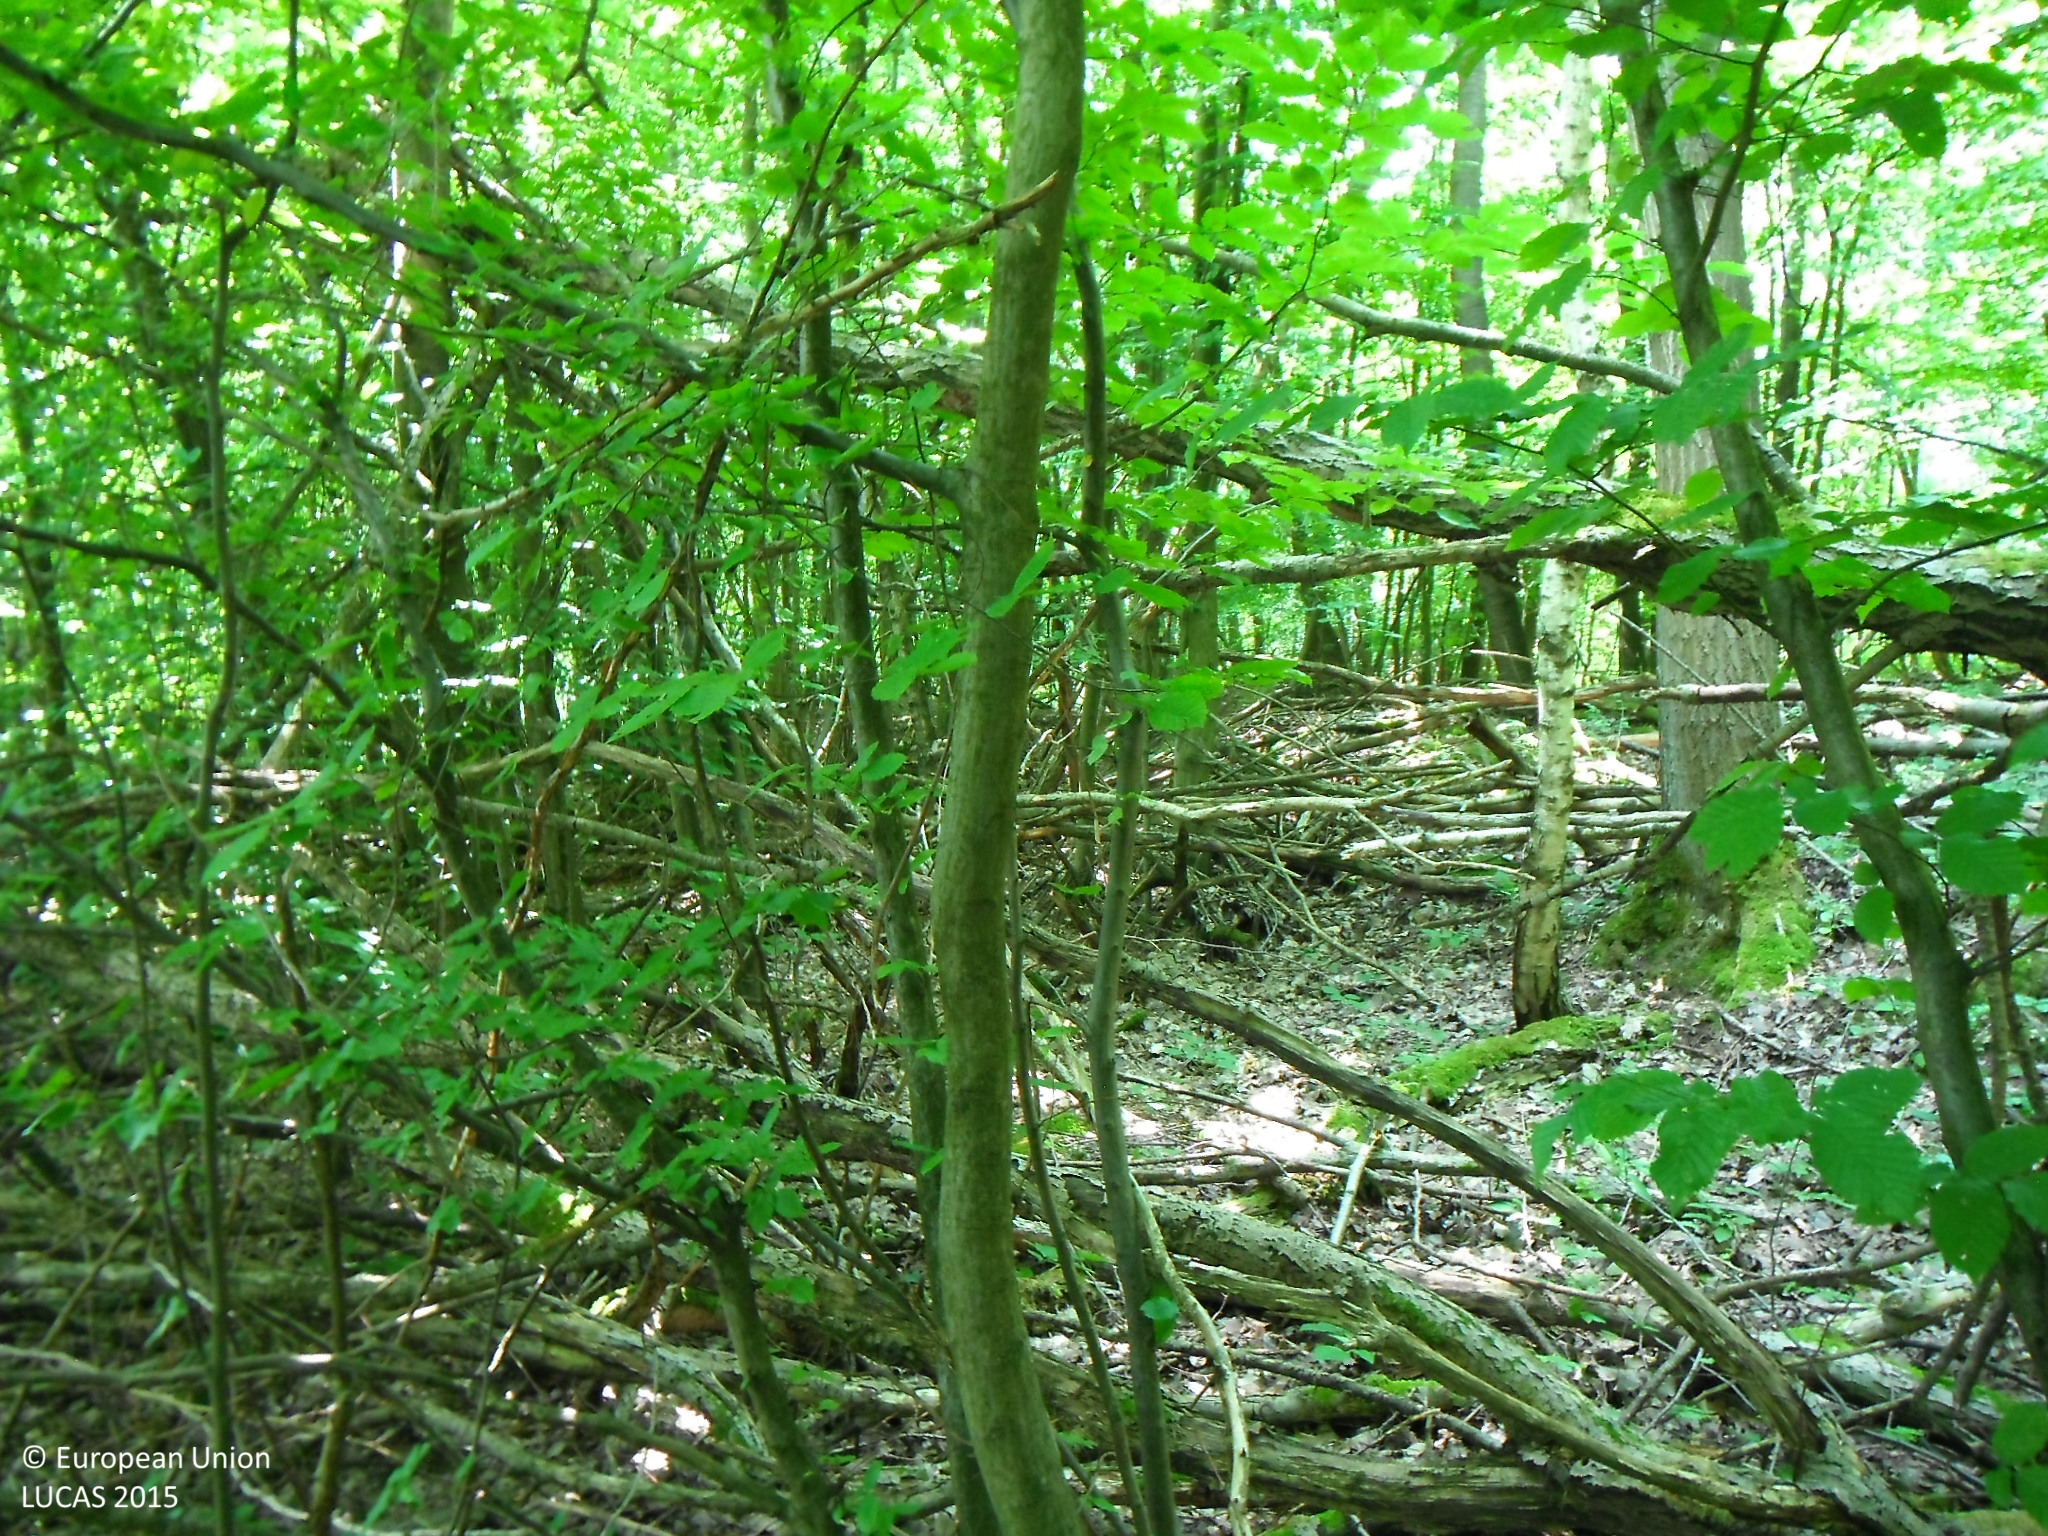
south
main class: Woodland
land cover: Broadleaved woodland
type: mesophytic deciduous forest
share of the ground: > 75 %
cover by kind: broadleaved forest trees 80 %, shrubs 20 %
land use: Forestry
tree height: > 5 m
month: July
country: SK
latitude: 49.2135
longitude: 21.3726
